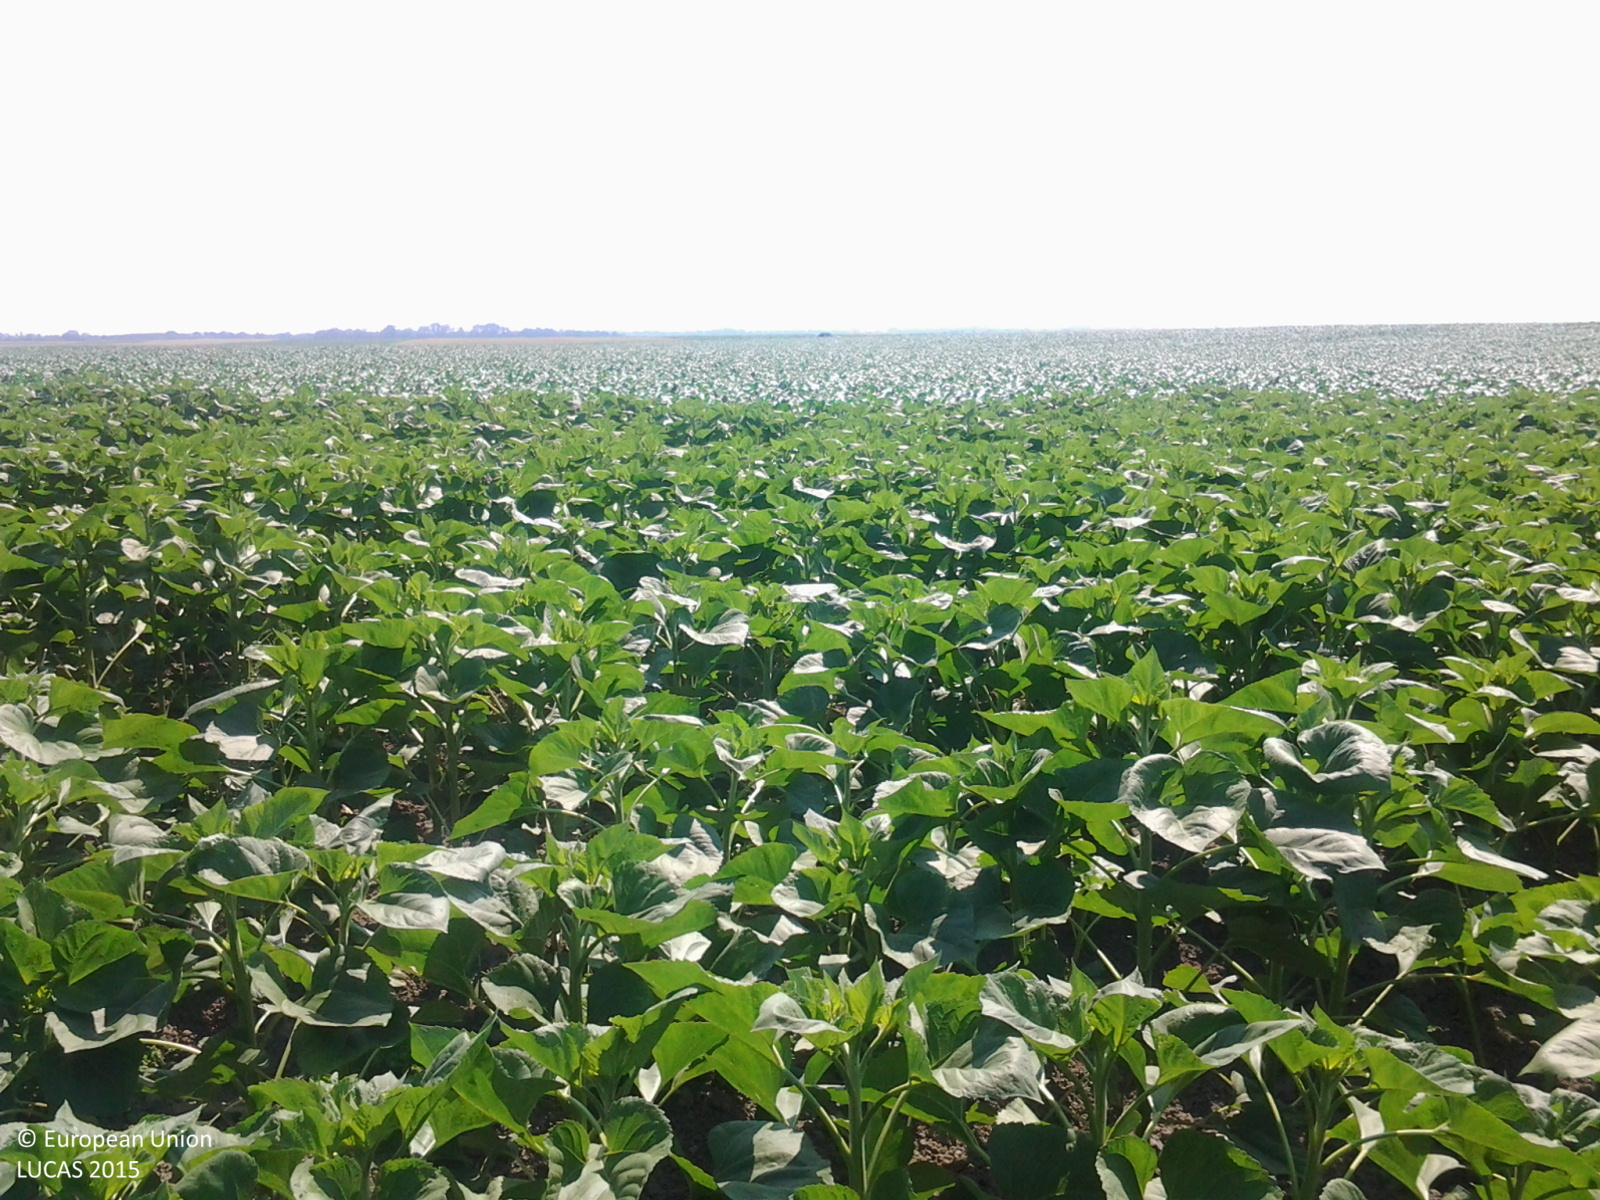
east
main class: Cropland
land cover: Sunflower
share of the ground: > 75 %
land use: Agriculture (excluding fallow land and kitchen gardens)
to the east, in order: Sunflower; Maize; Grass margins; Tracks; Grass margins; Maize
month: June
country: HU
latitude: 46.6267
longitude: 18.9604
